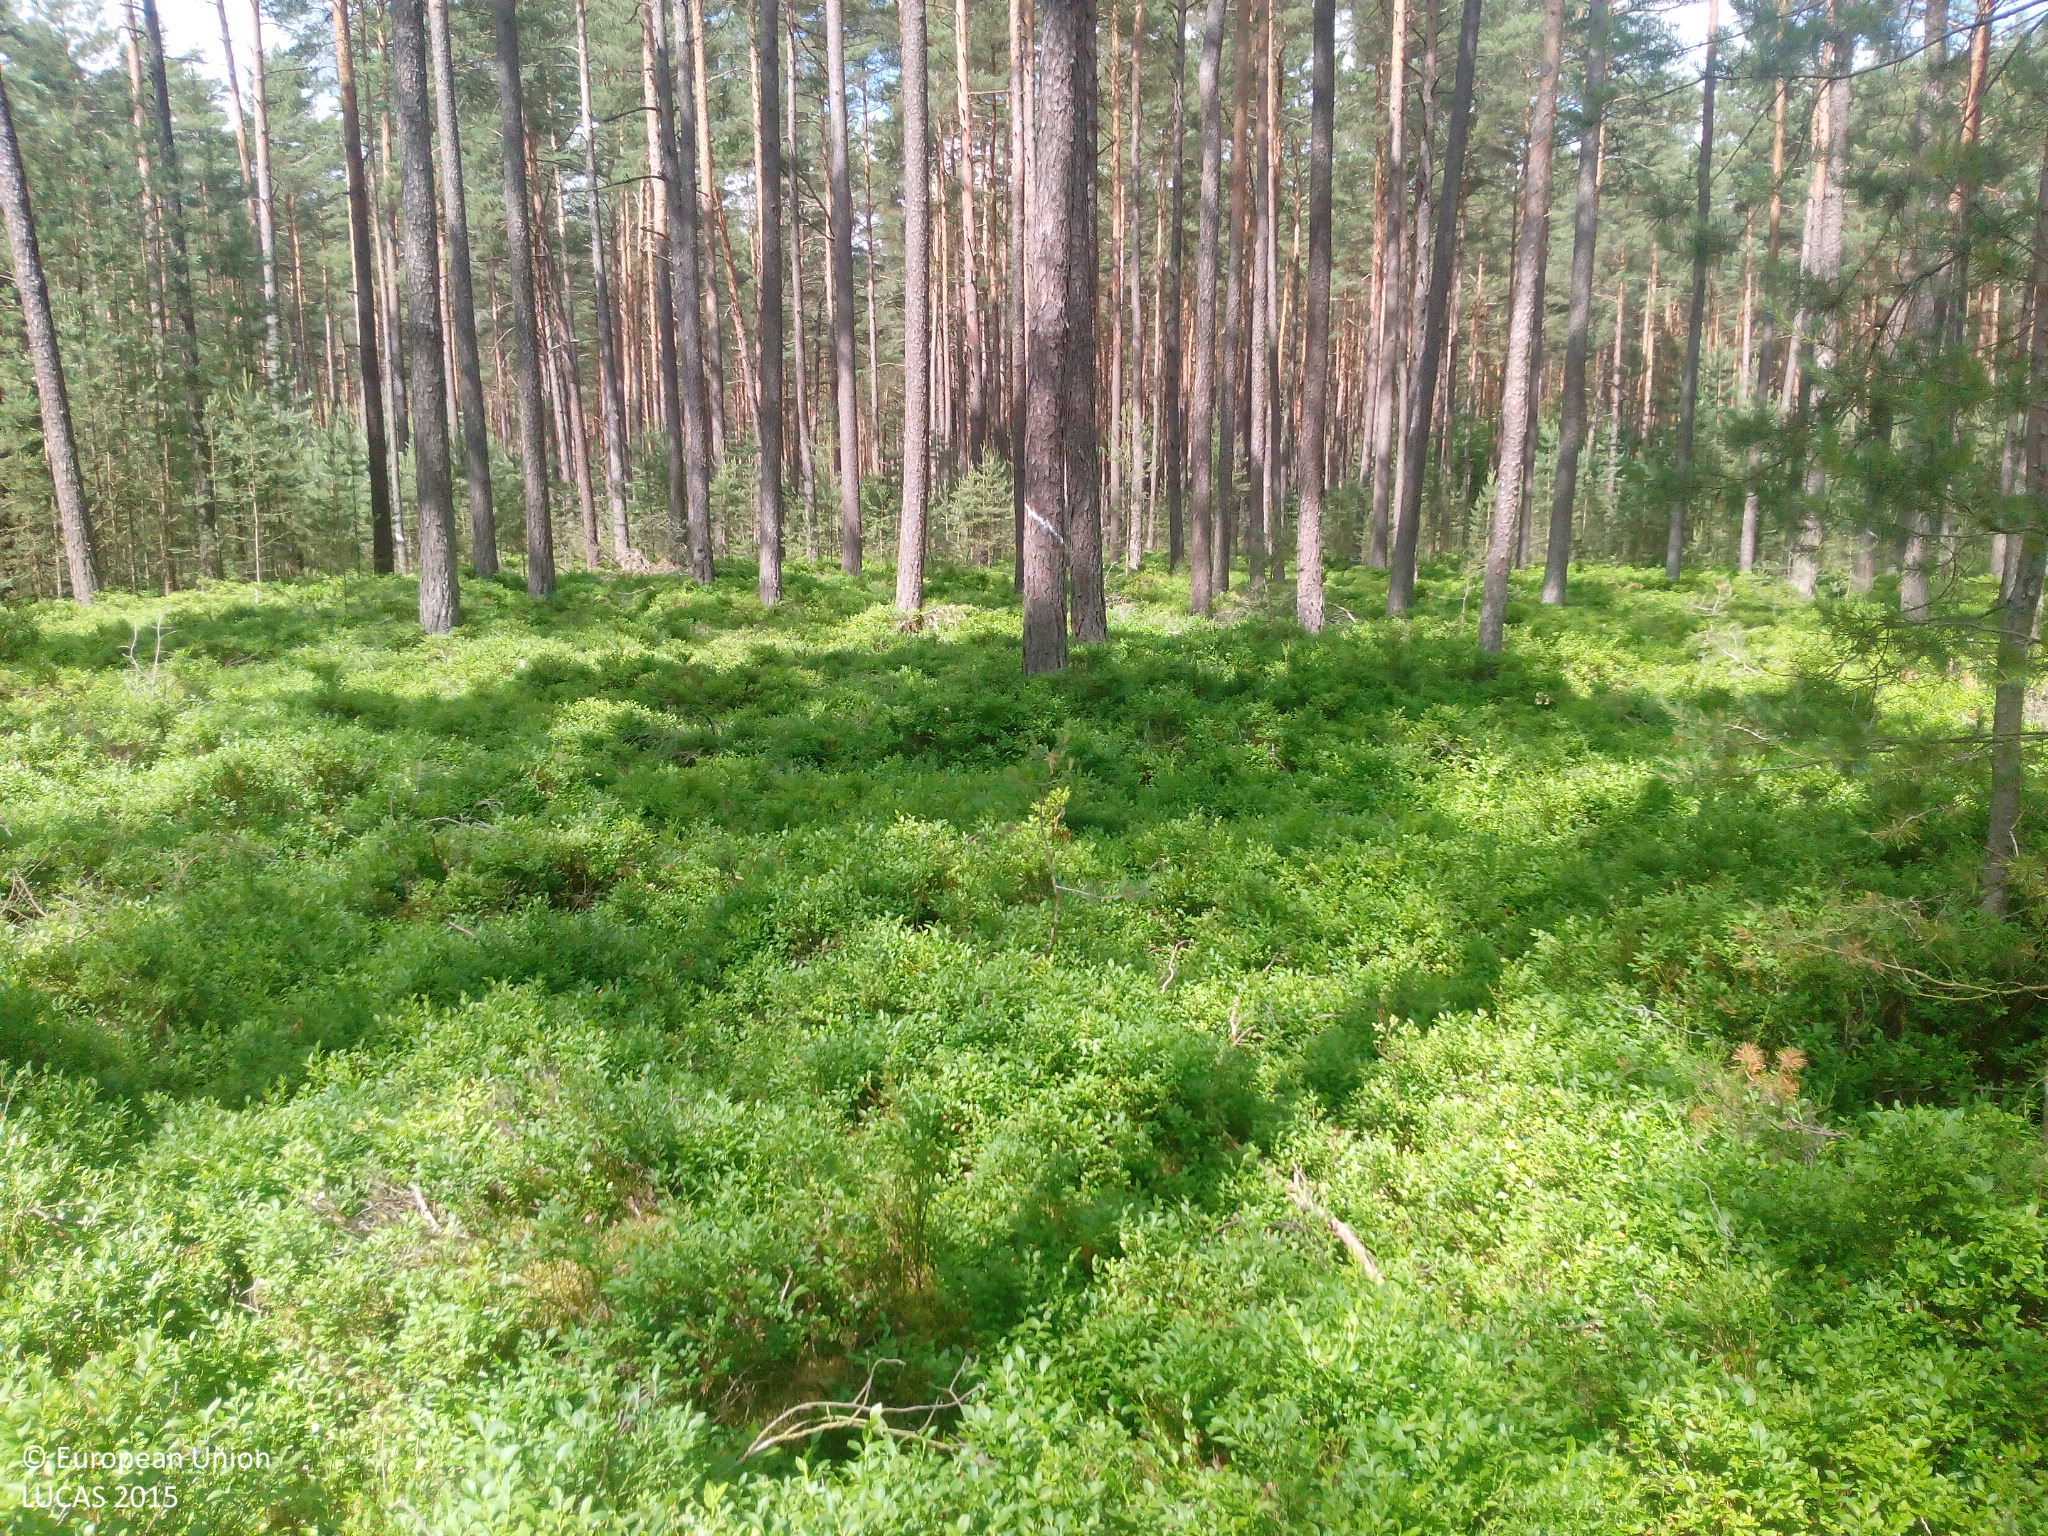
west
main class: Woodland
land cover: Pine dominated coniferous woodland
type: hemiboreal forest and nemoral coniferous forest and mixed broadleaved-coniferous forest
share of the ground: > 75 %
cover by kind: coniferous forest trees 75 %, shrubs 20 %, herbaceous plants 5 %
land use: Forestry
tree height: > 5 m
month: June
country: DE
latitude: 49.2453
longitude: 10.9200
